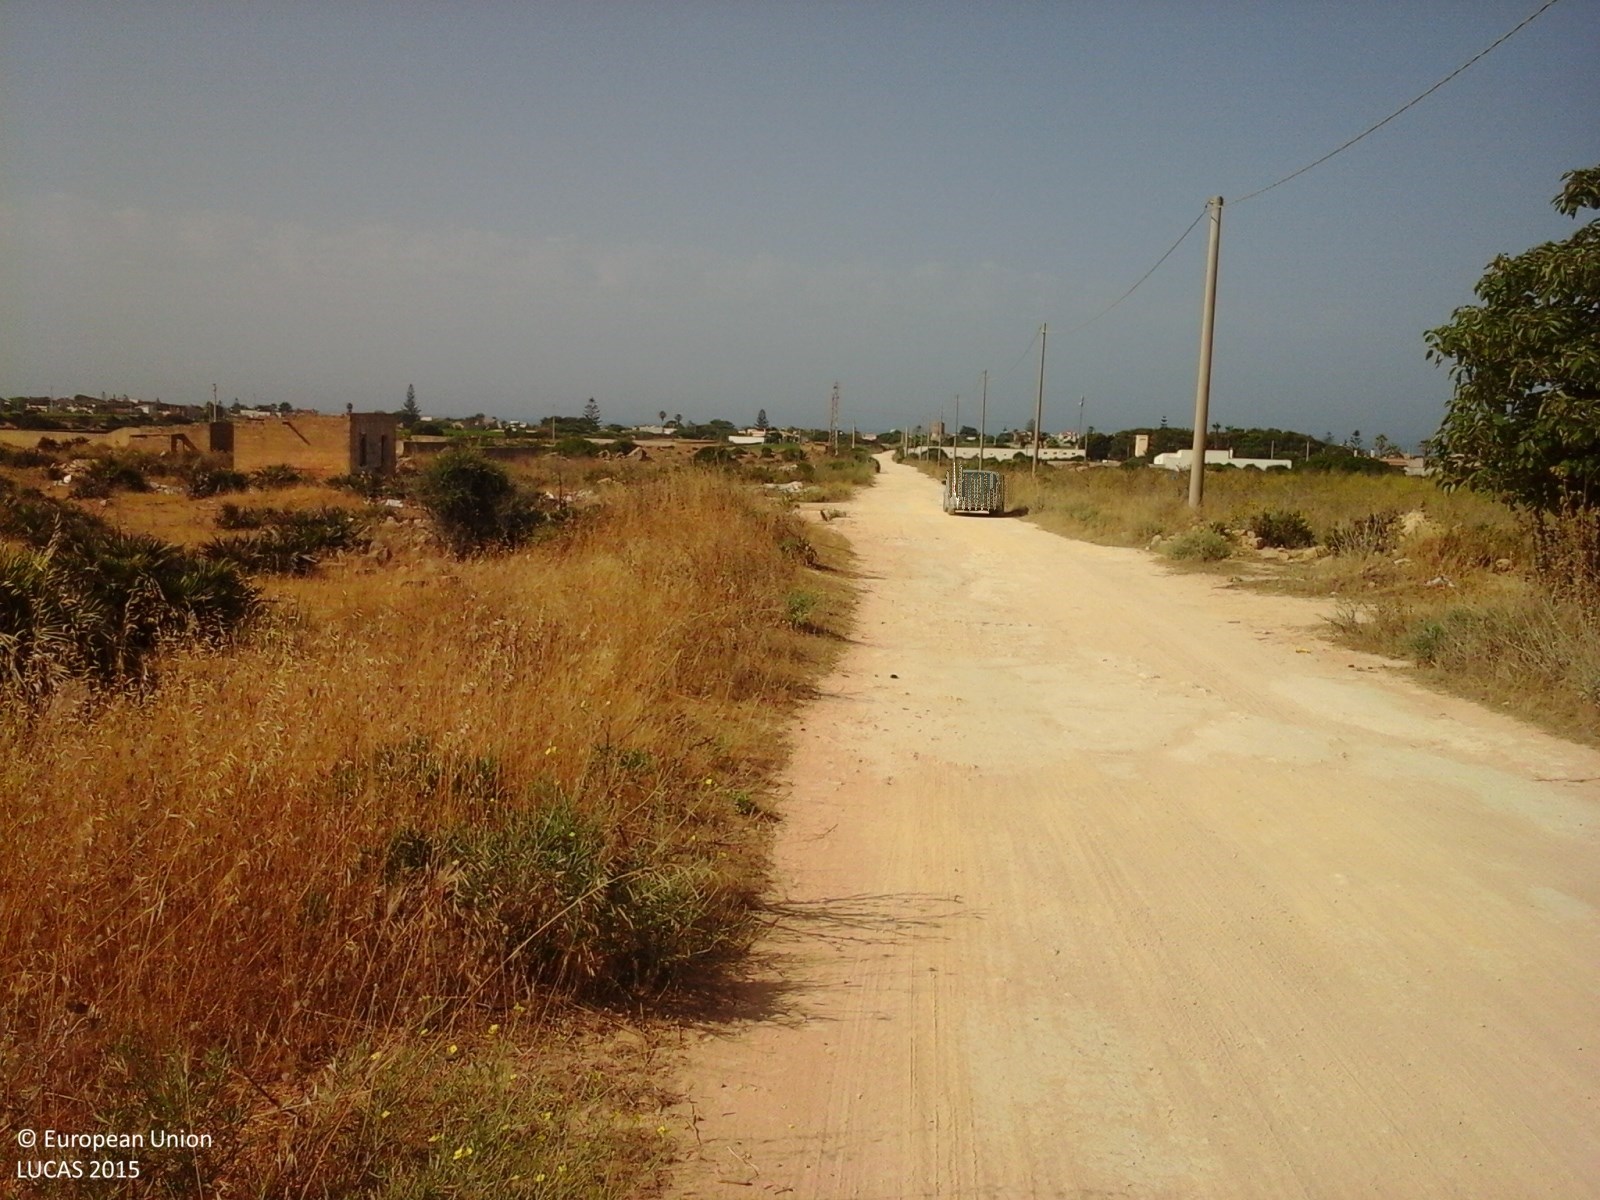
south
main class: Cropland
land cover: Other fresh vegetables
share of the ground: > 75 %
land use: Agriculture (excluding fallow land and kitchen gardens)
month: May
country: IT
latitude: 37.5831
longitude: 12.6633
